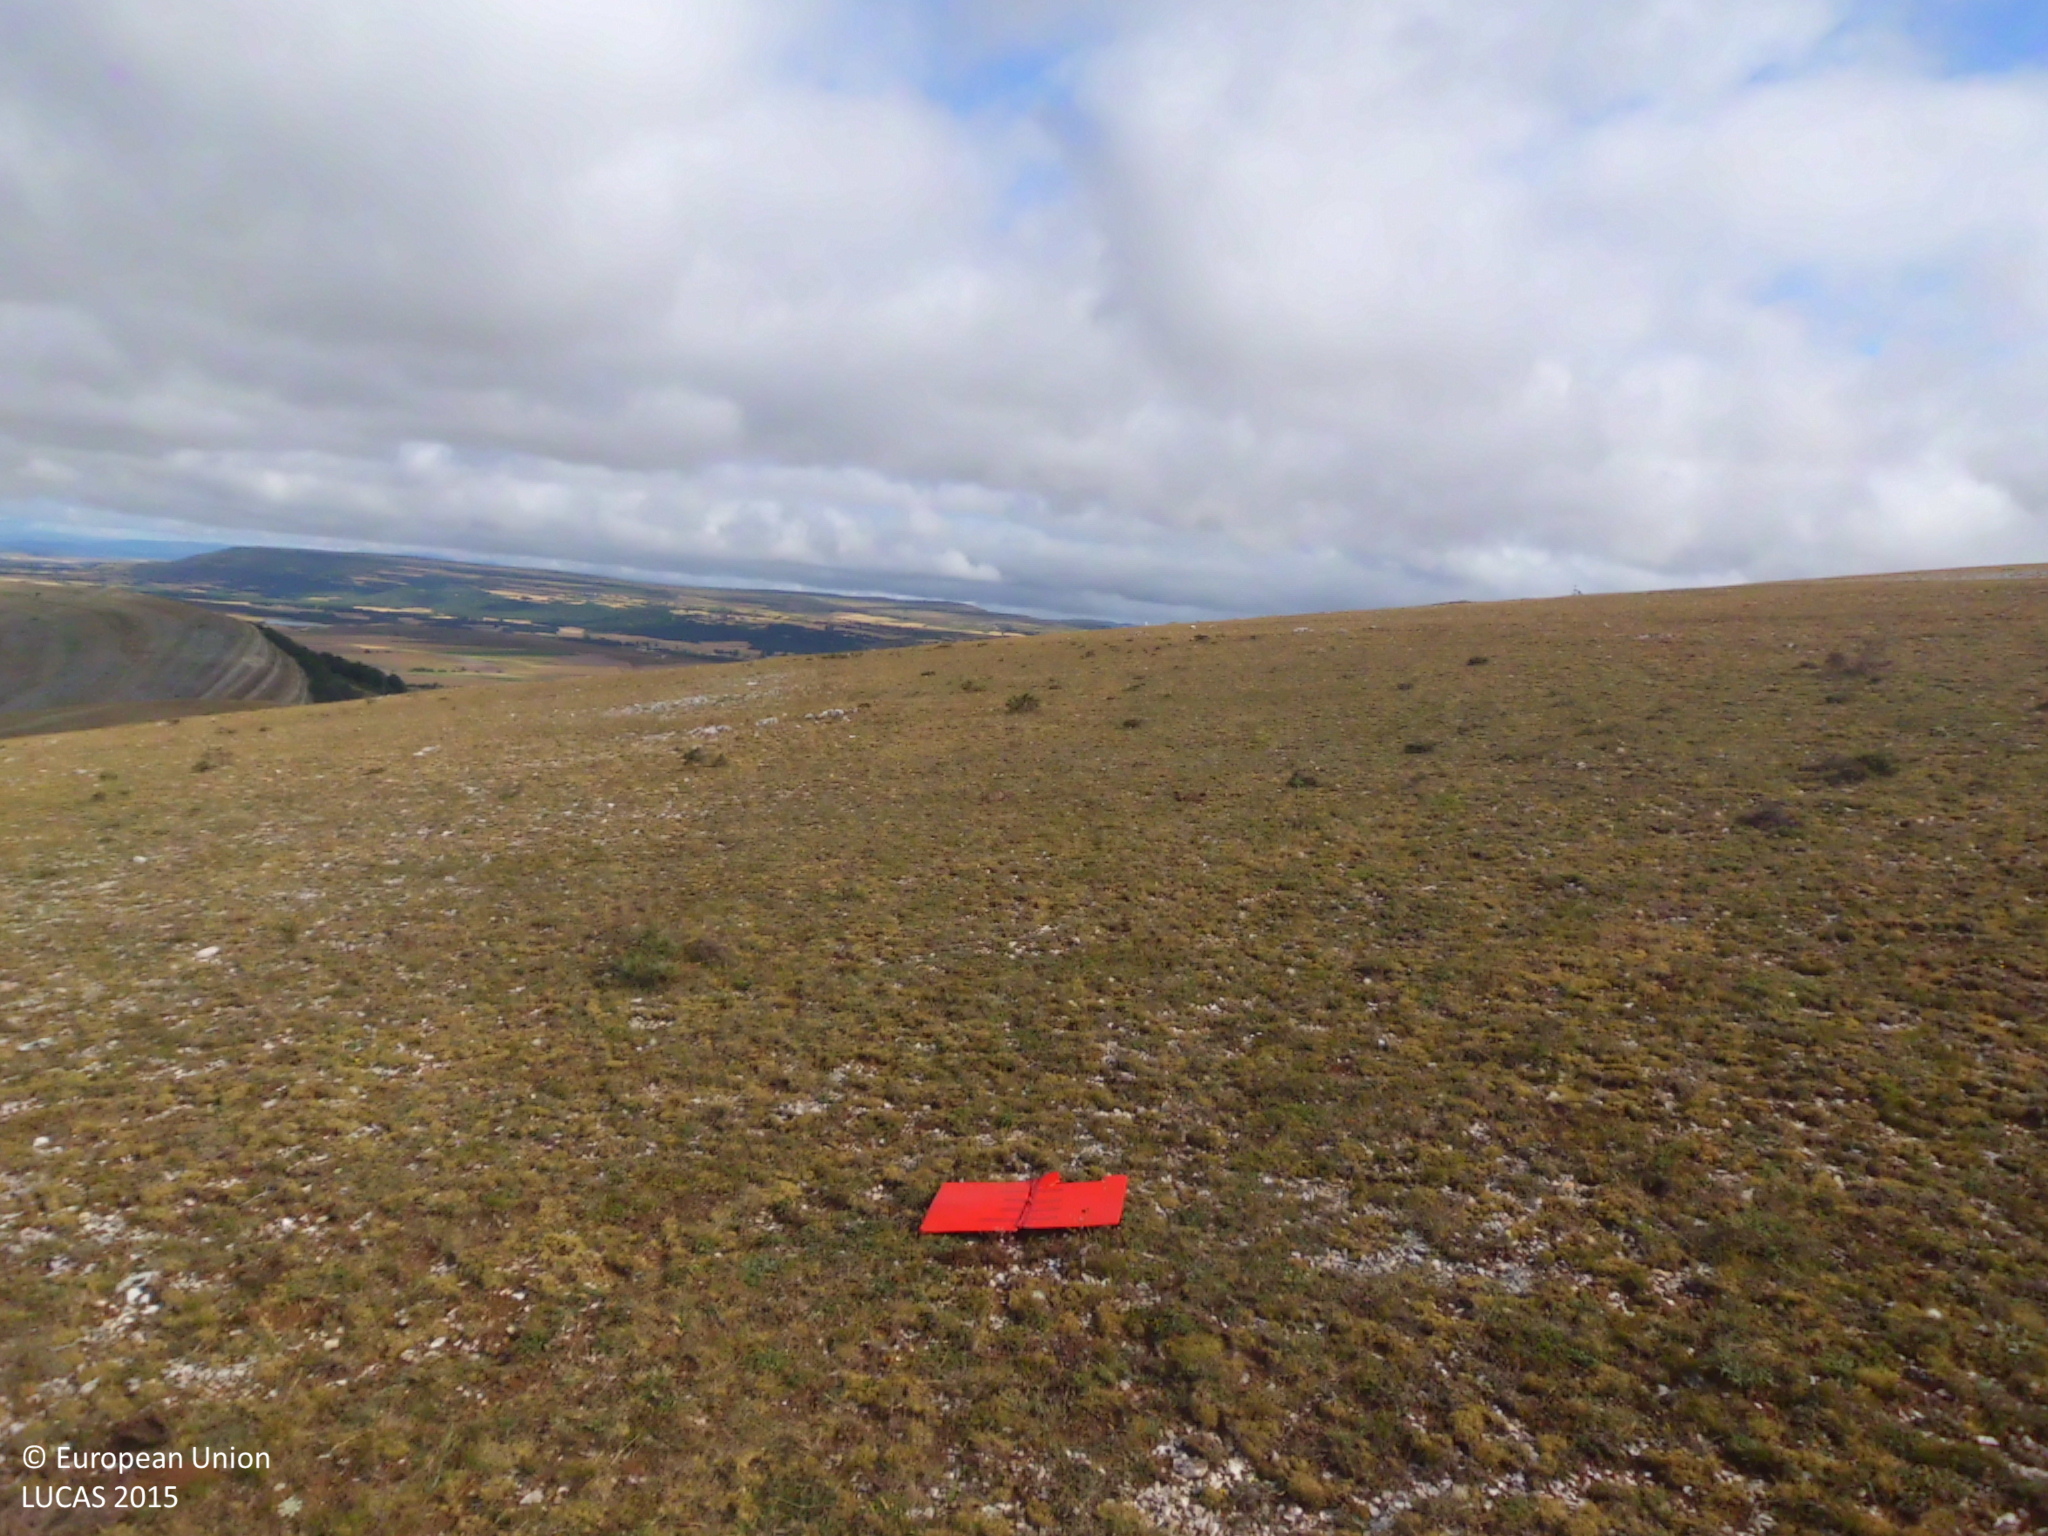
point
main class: Grassland
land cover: Grassland without tree/shrub cover
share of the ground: 50 - 75 %
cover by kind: herbaceous plants 50 %, consolidated bare surface 50 %
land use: Agriculture (excluding fallow land and kitchen gardens)
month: July
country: ES
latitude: 42.6946
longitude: -4.0462
